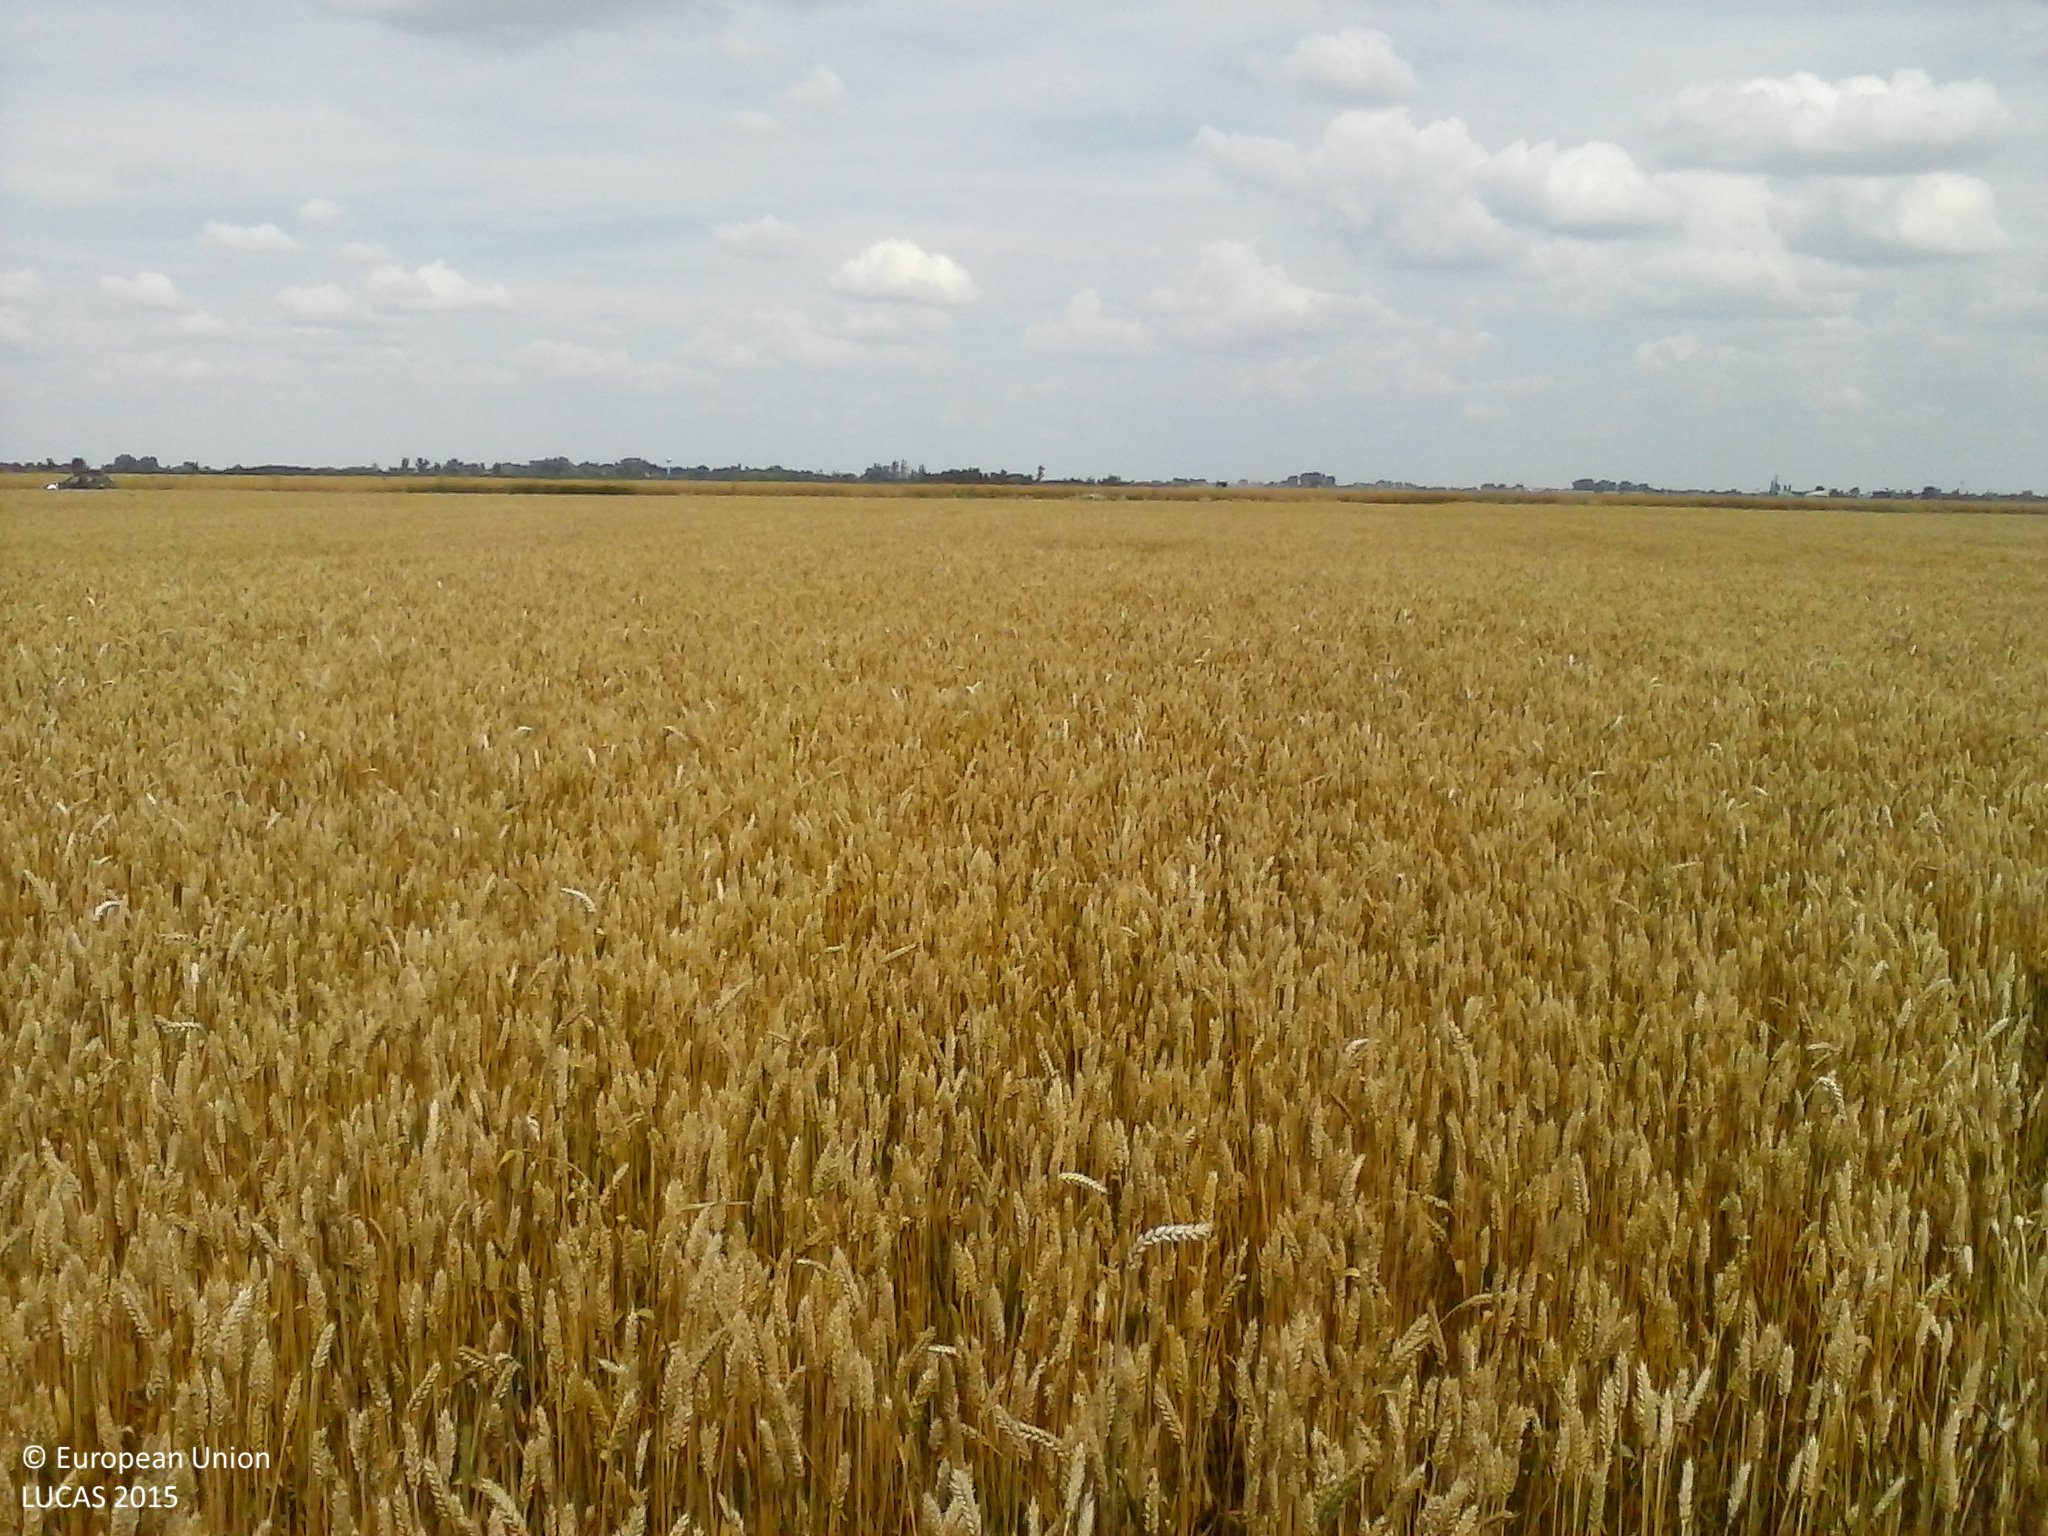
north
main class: Cropland
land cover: Common wheat
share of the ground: > 75 %
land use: Agriculture (excluding fallow land and kitchen gardens)
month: June
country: HU
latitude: 46.3504
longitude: 20.4077
